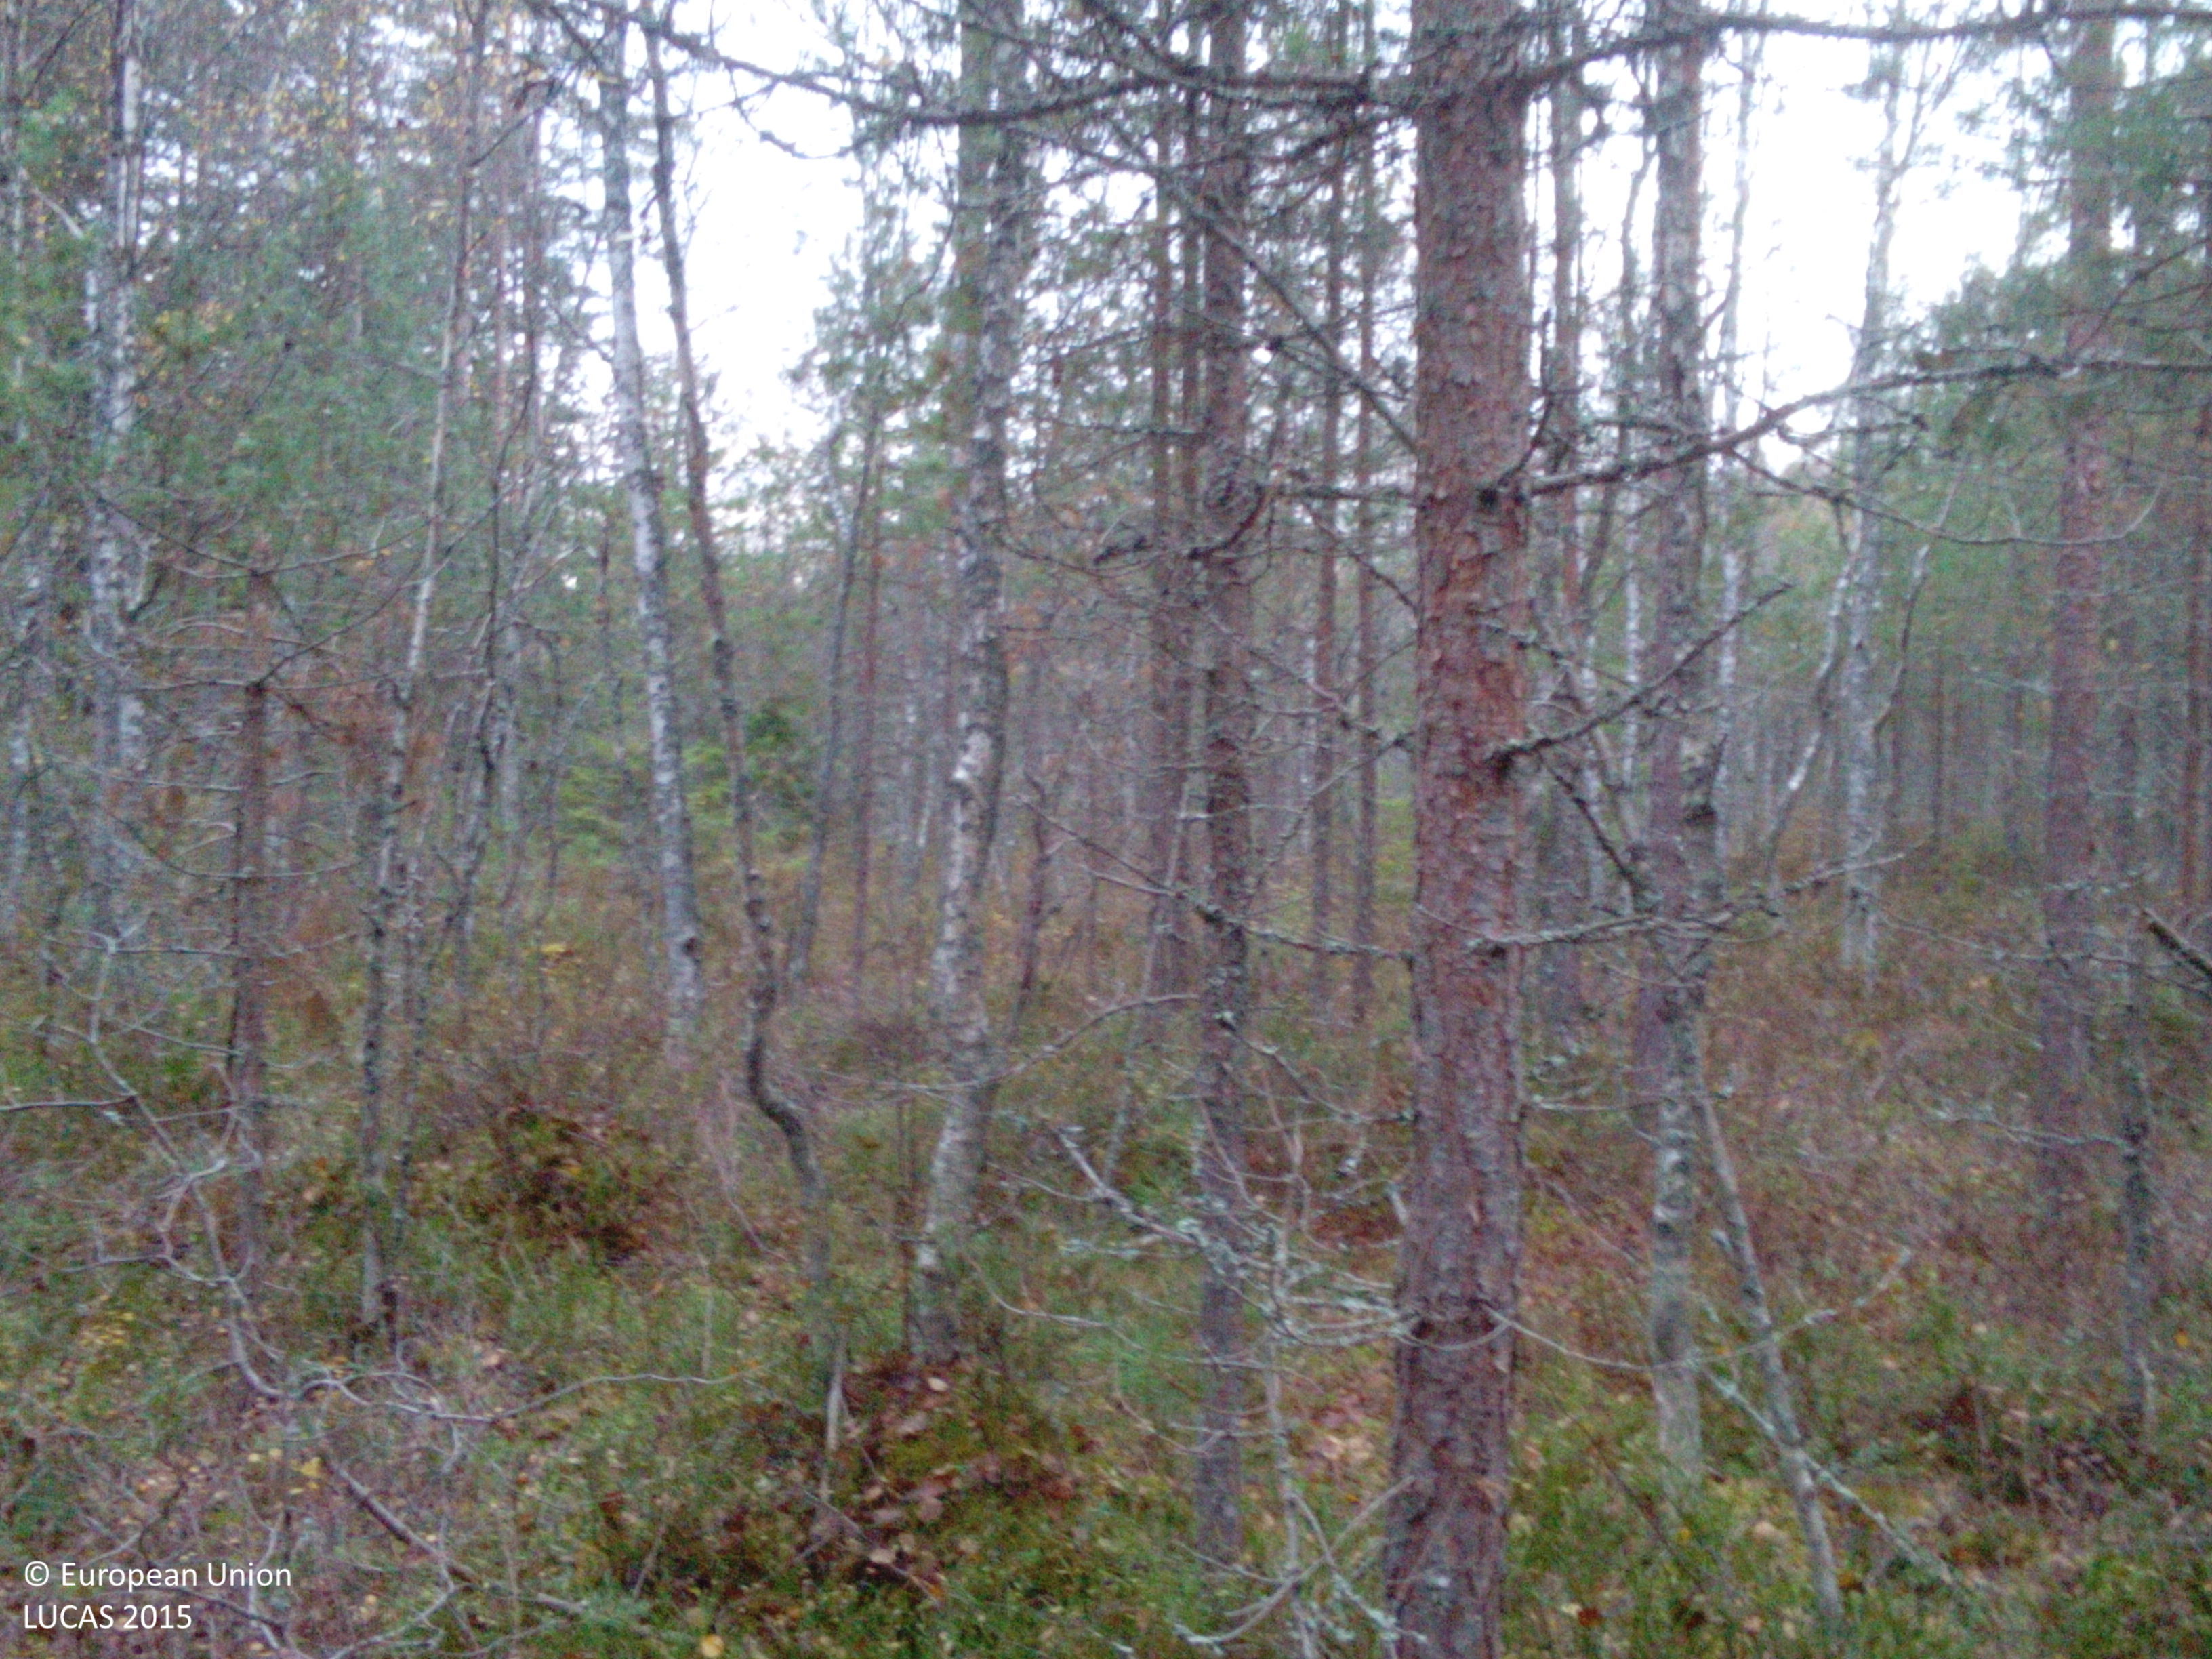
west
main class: Woodland
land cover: Pine dominated mixed woodland
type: boreal forest
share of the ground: > 75 %
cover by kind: coniferous forest trees 40 %, broadleaved forest trees 40 %, herbaceous plants 10 %, lichens and mosses 10 %
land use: Forestry
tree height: > 5 m
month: October
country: SE
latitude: 59.2557
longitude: 16.4648
